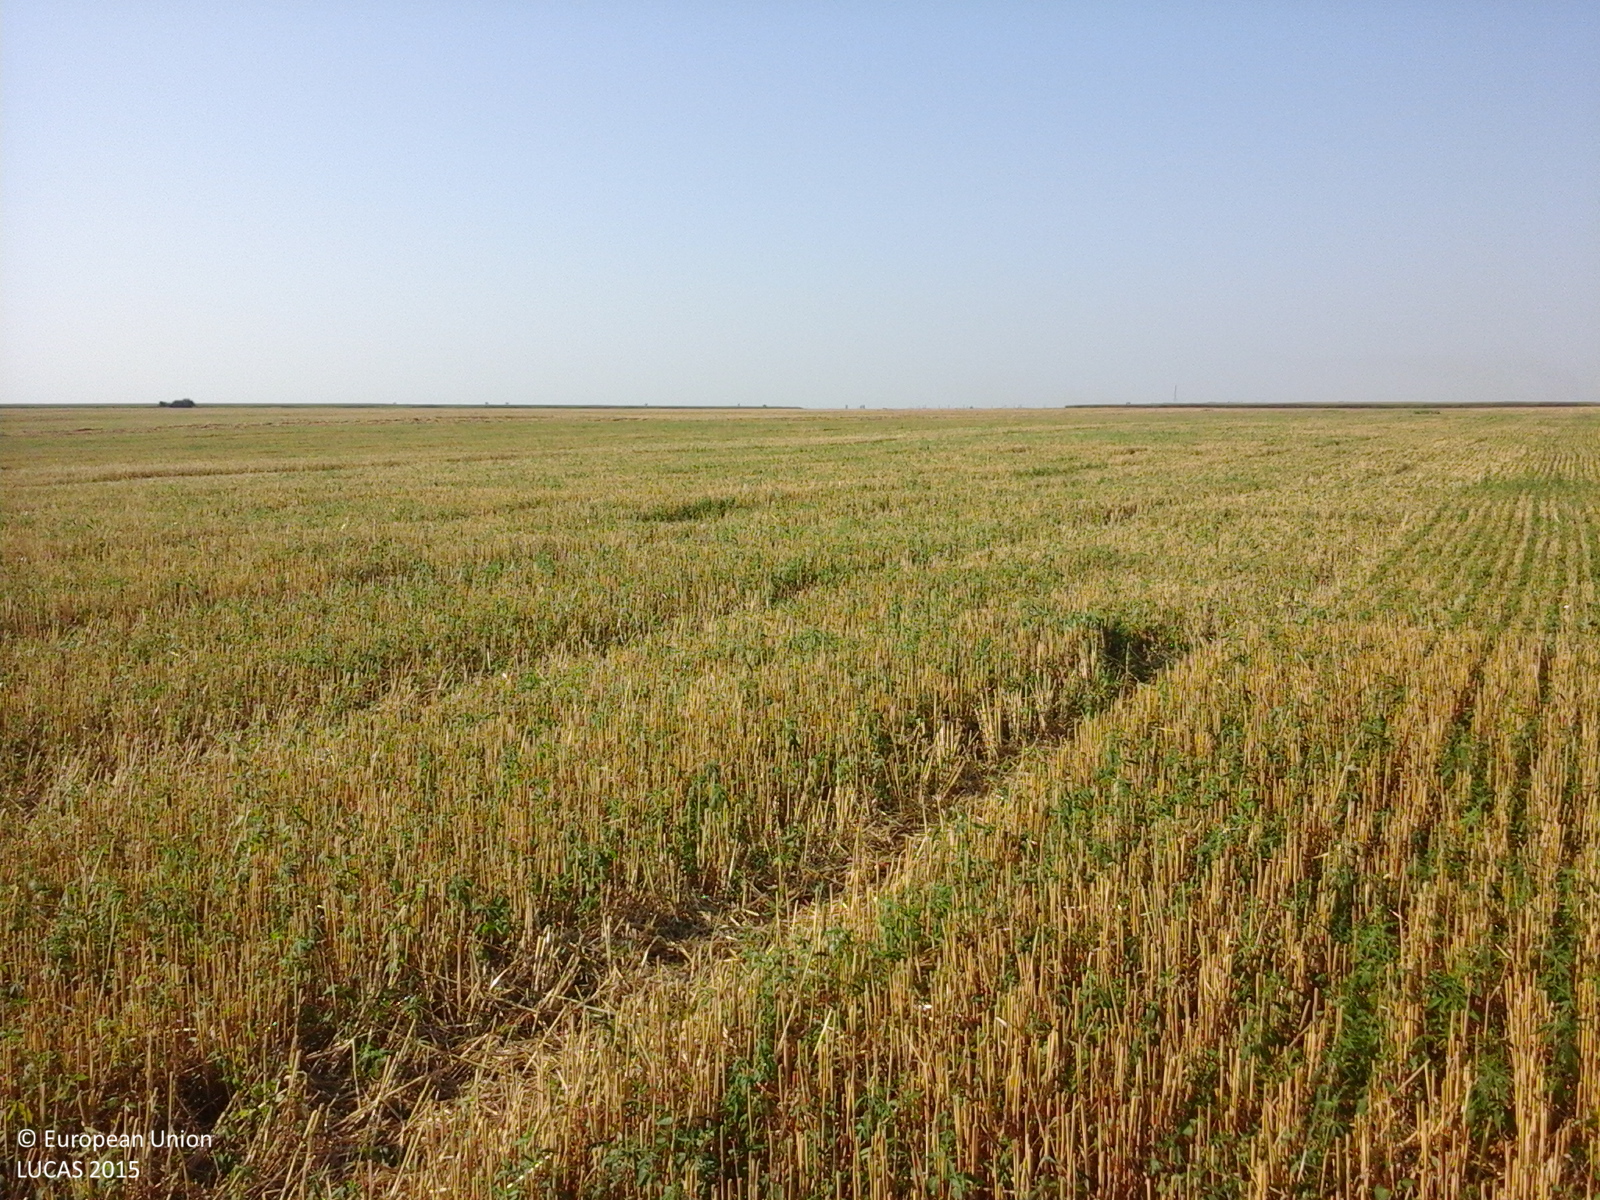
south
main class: Cropland
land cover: Common wheat
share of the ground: > 75 %
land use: Agriculture (excluding fallow land and kitchen gardens)
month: July
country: RO
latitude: 44.4220
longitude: 27.0221
